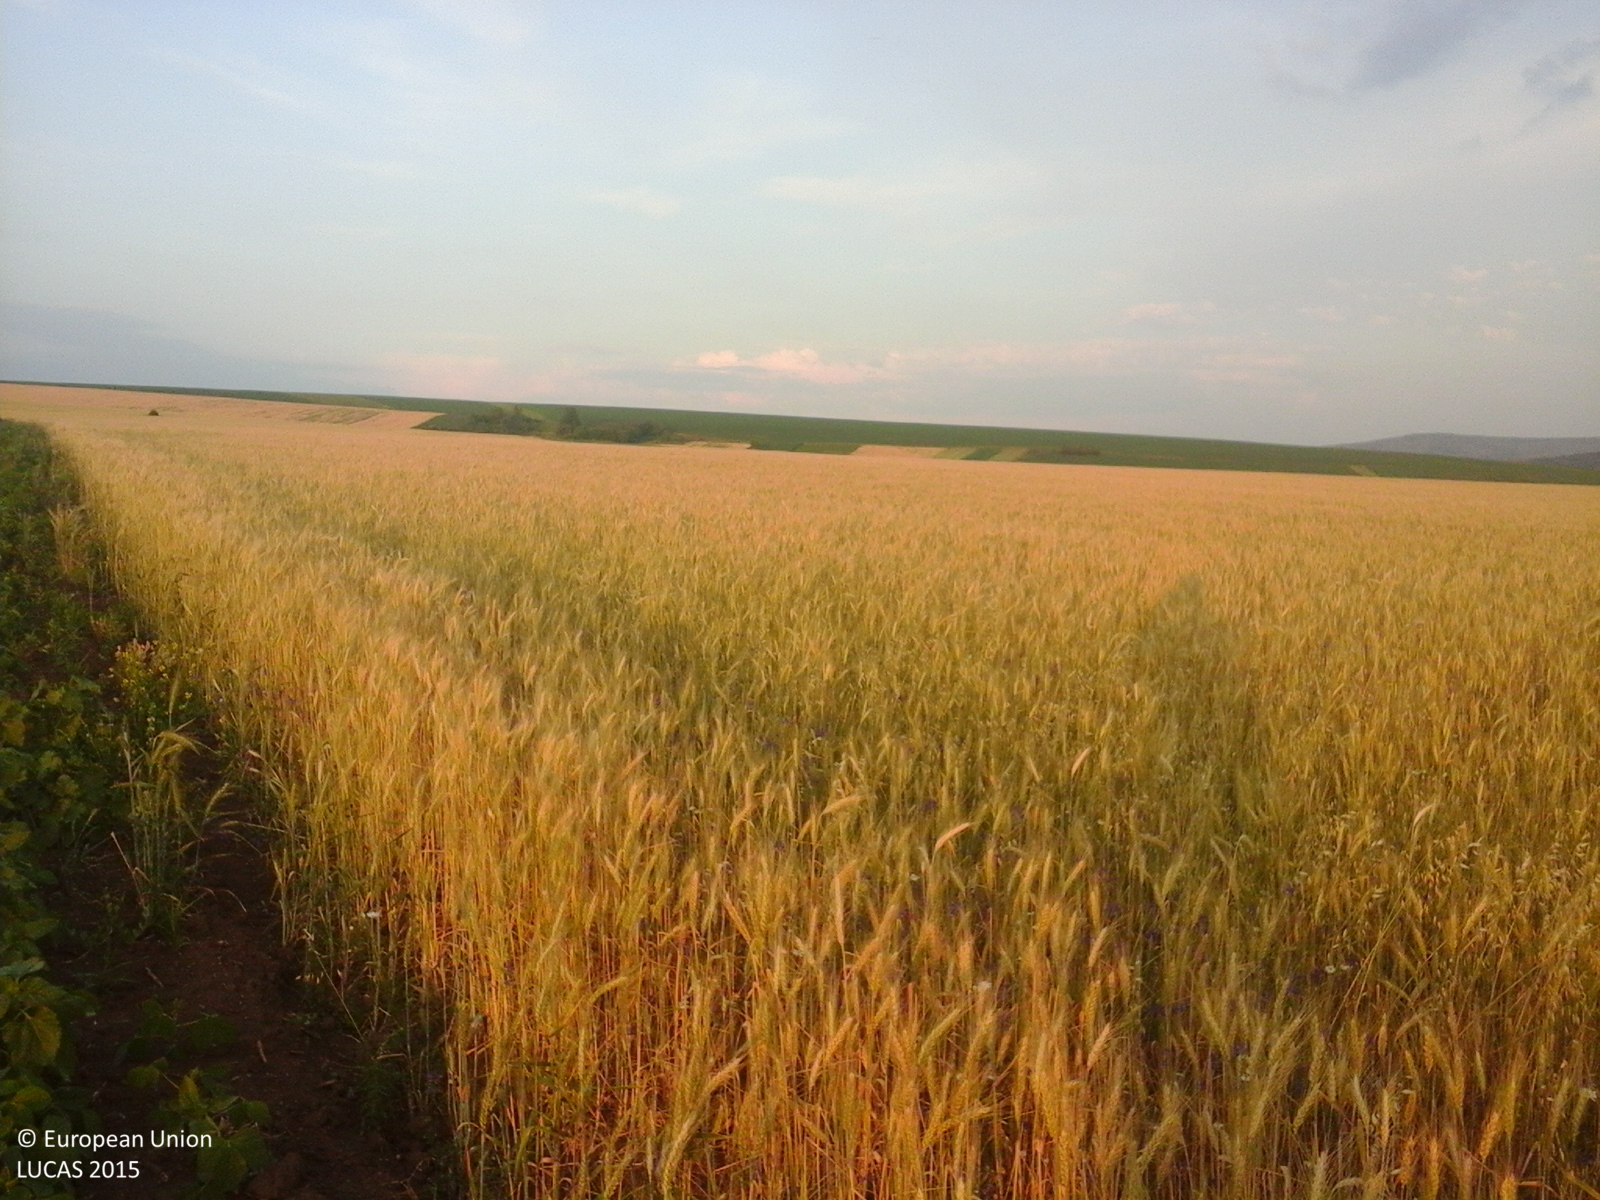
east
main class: Cropland
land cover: Soya
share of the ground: 50 - 75 %
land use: Agriculture (excluding fallow land and kitchen gardens)
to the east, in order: Common wheat; Tracks; Common wheat
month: June
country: RO
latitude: 46.8553
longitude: 27.3294
